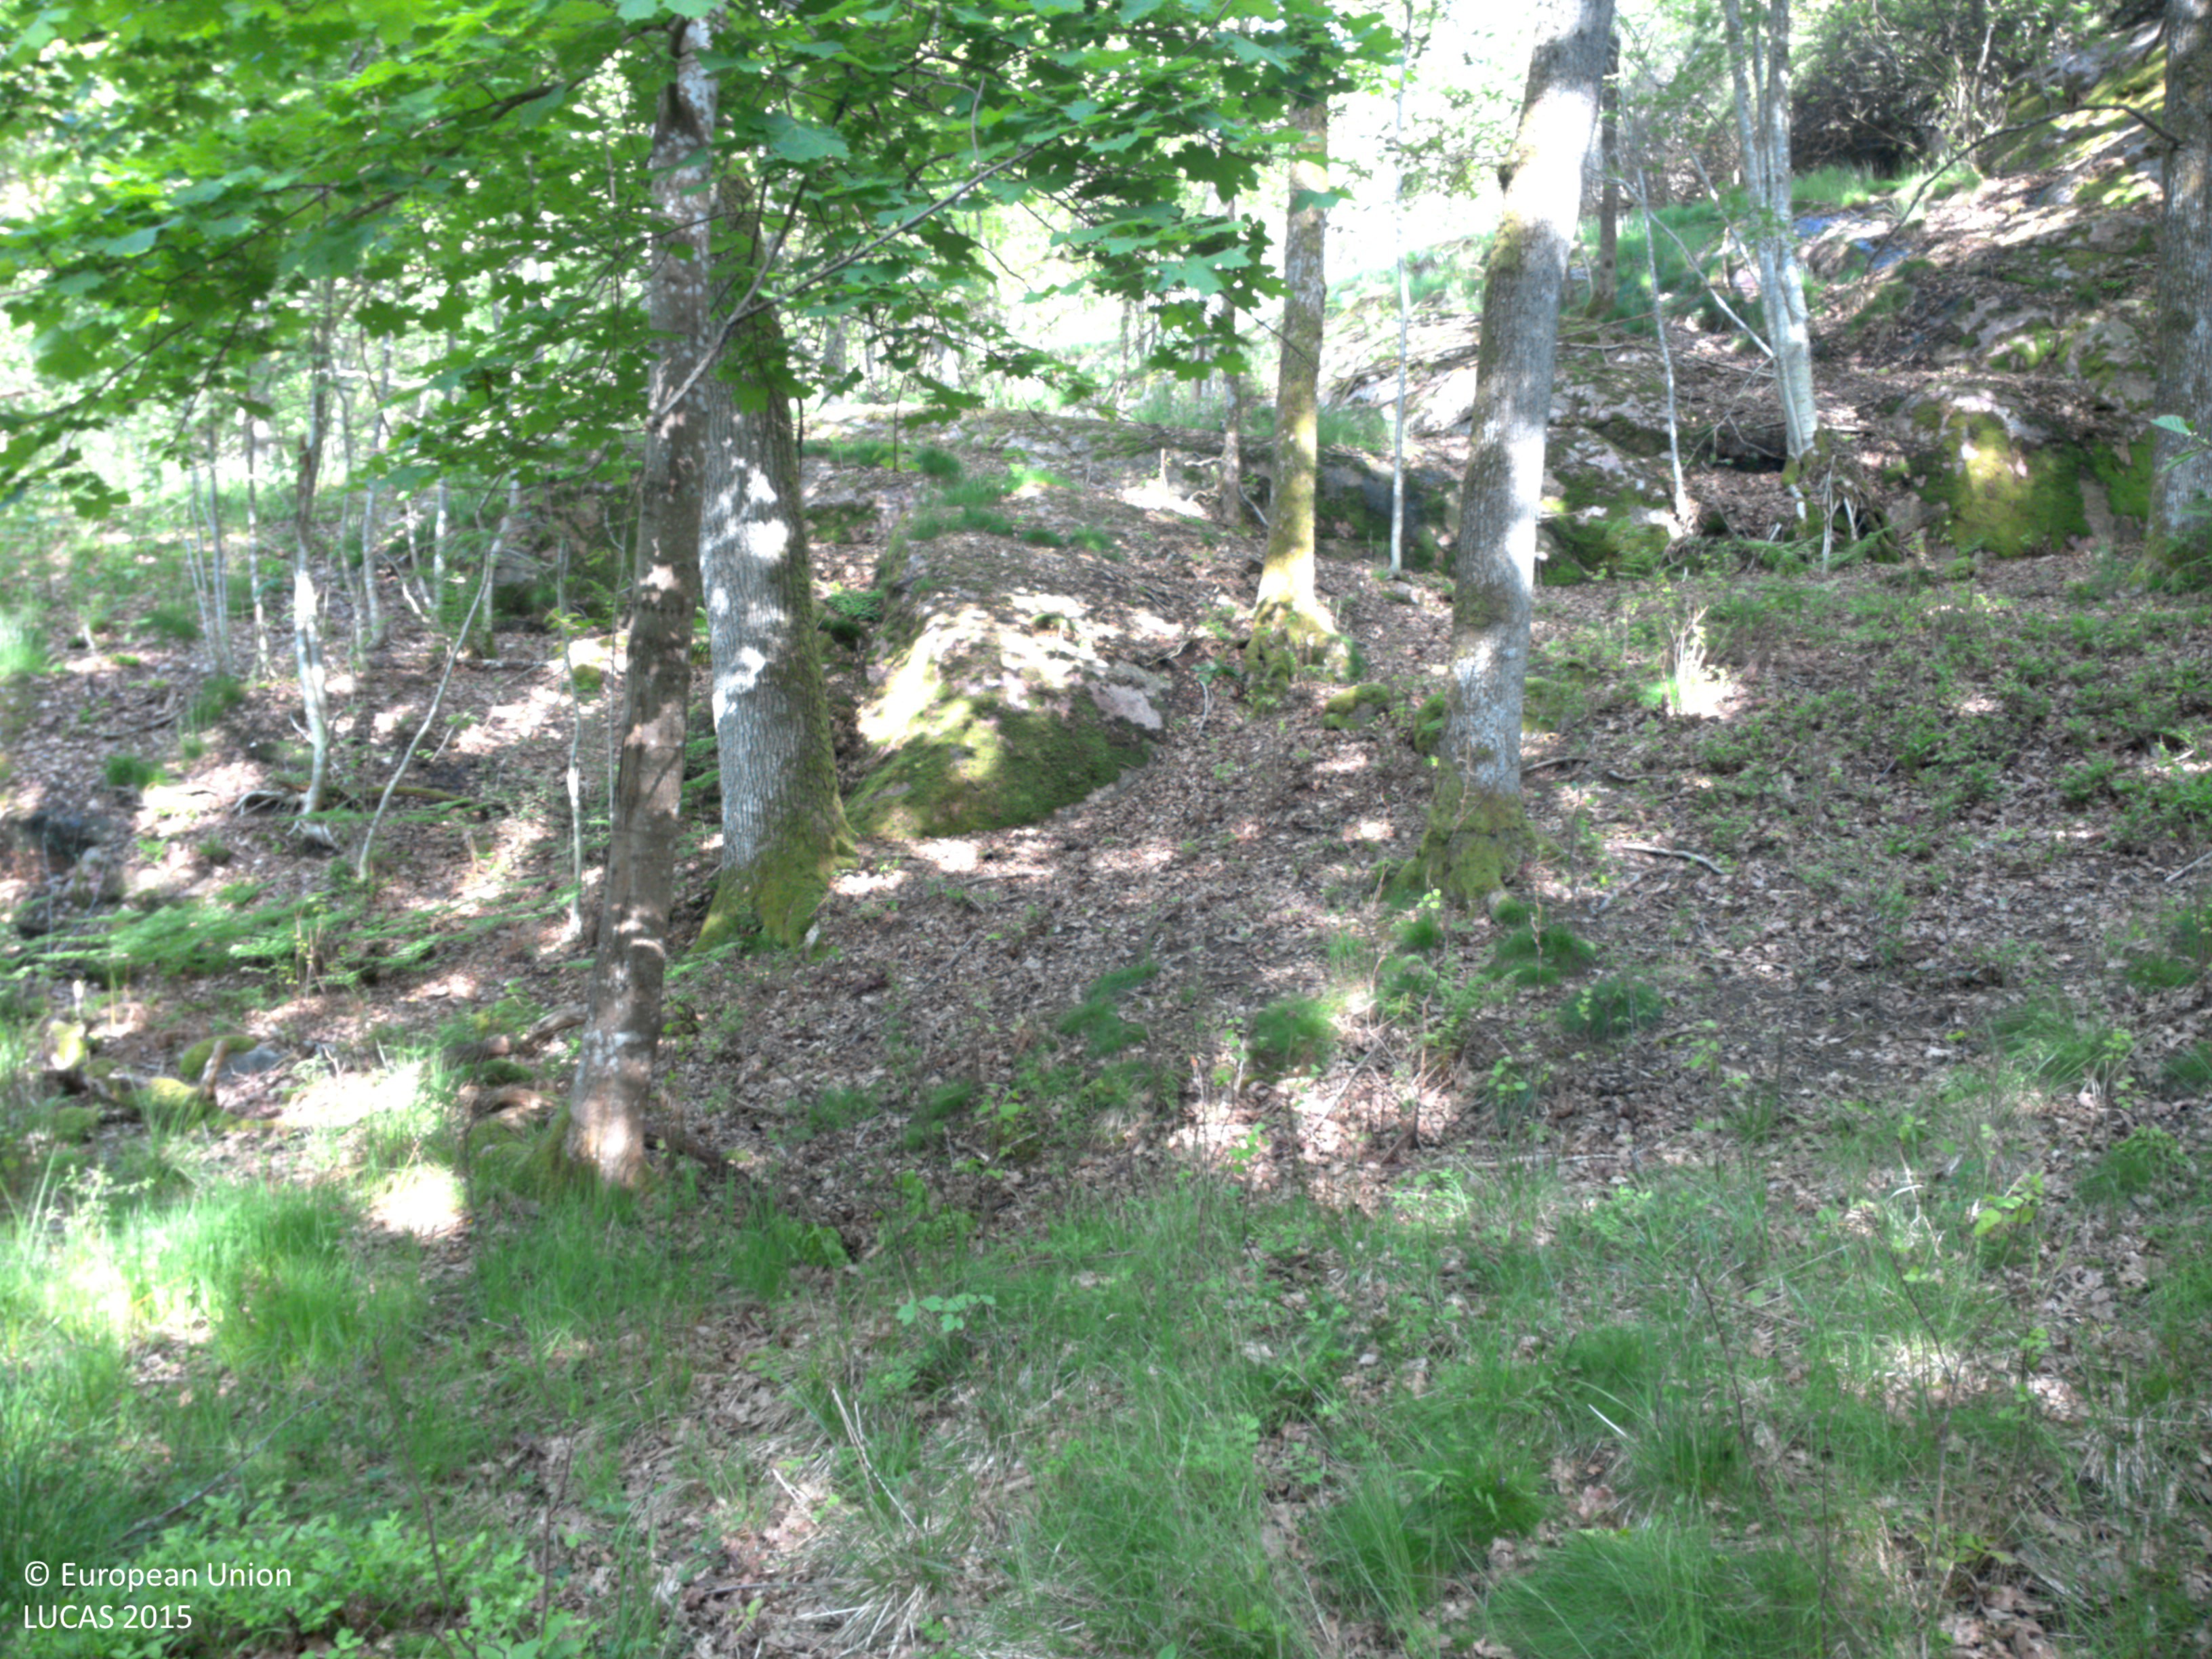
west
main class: Woodland
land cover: Broadleaved woodland
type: mesophytic deciduous forest
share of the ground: 50 - 75 %
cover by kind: broadleaved forest trees 65 %, herbaceous plants 30 %, coniferous forest trees 5 %
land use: Forestry
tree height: > 5 m
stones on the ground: 10 - 25 %
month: June
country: SE
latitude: 58.3506
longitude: 11.8587
